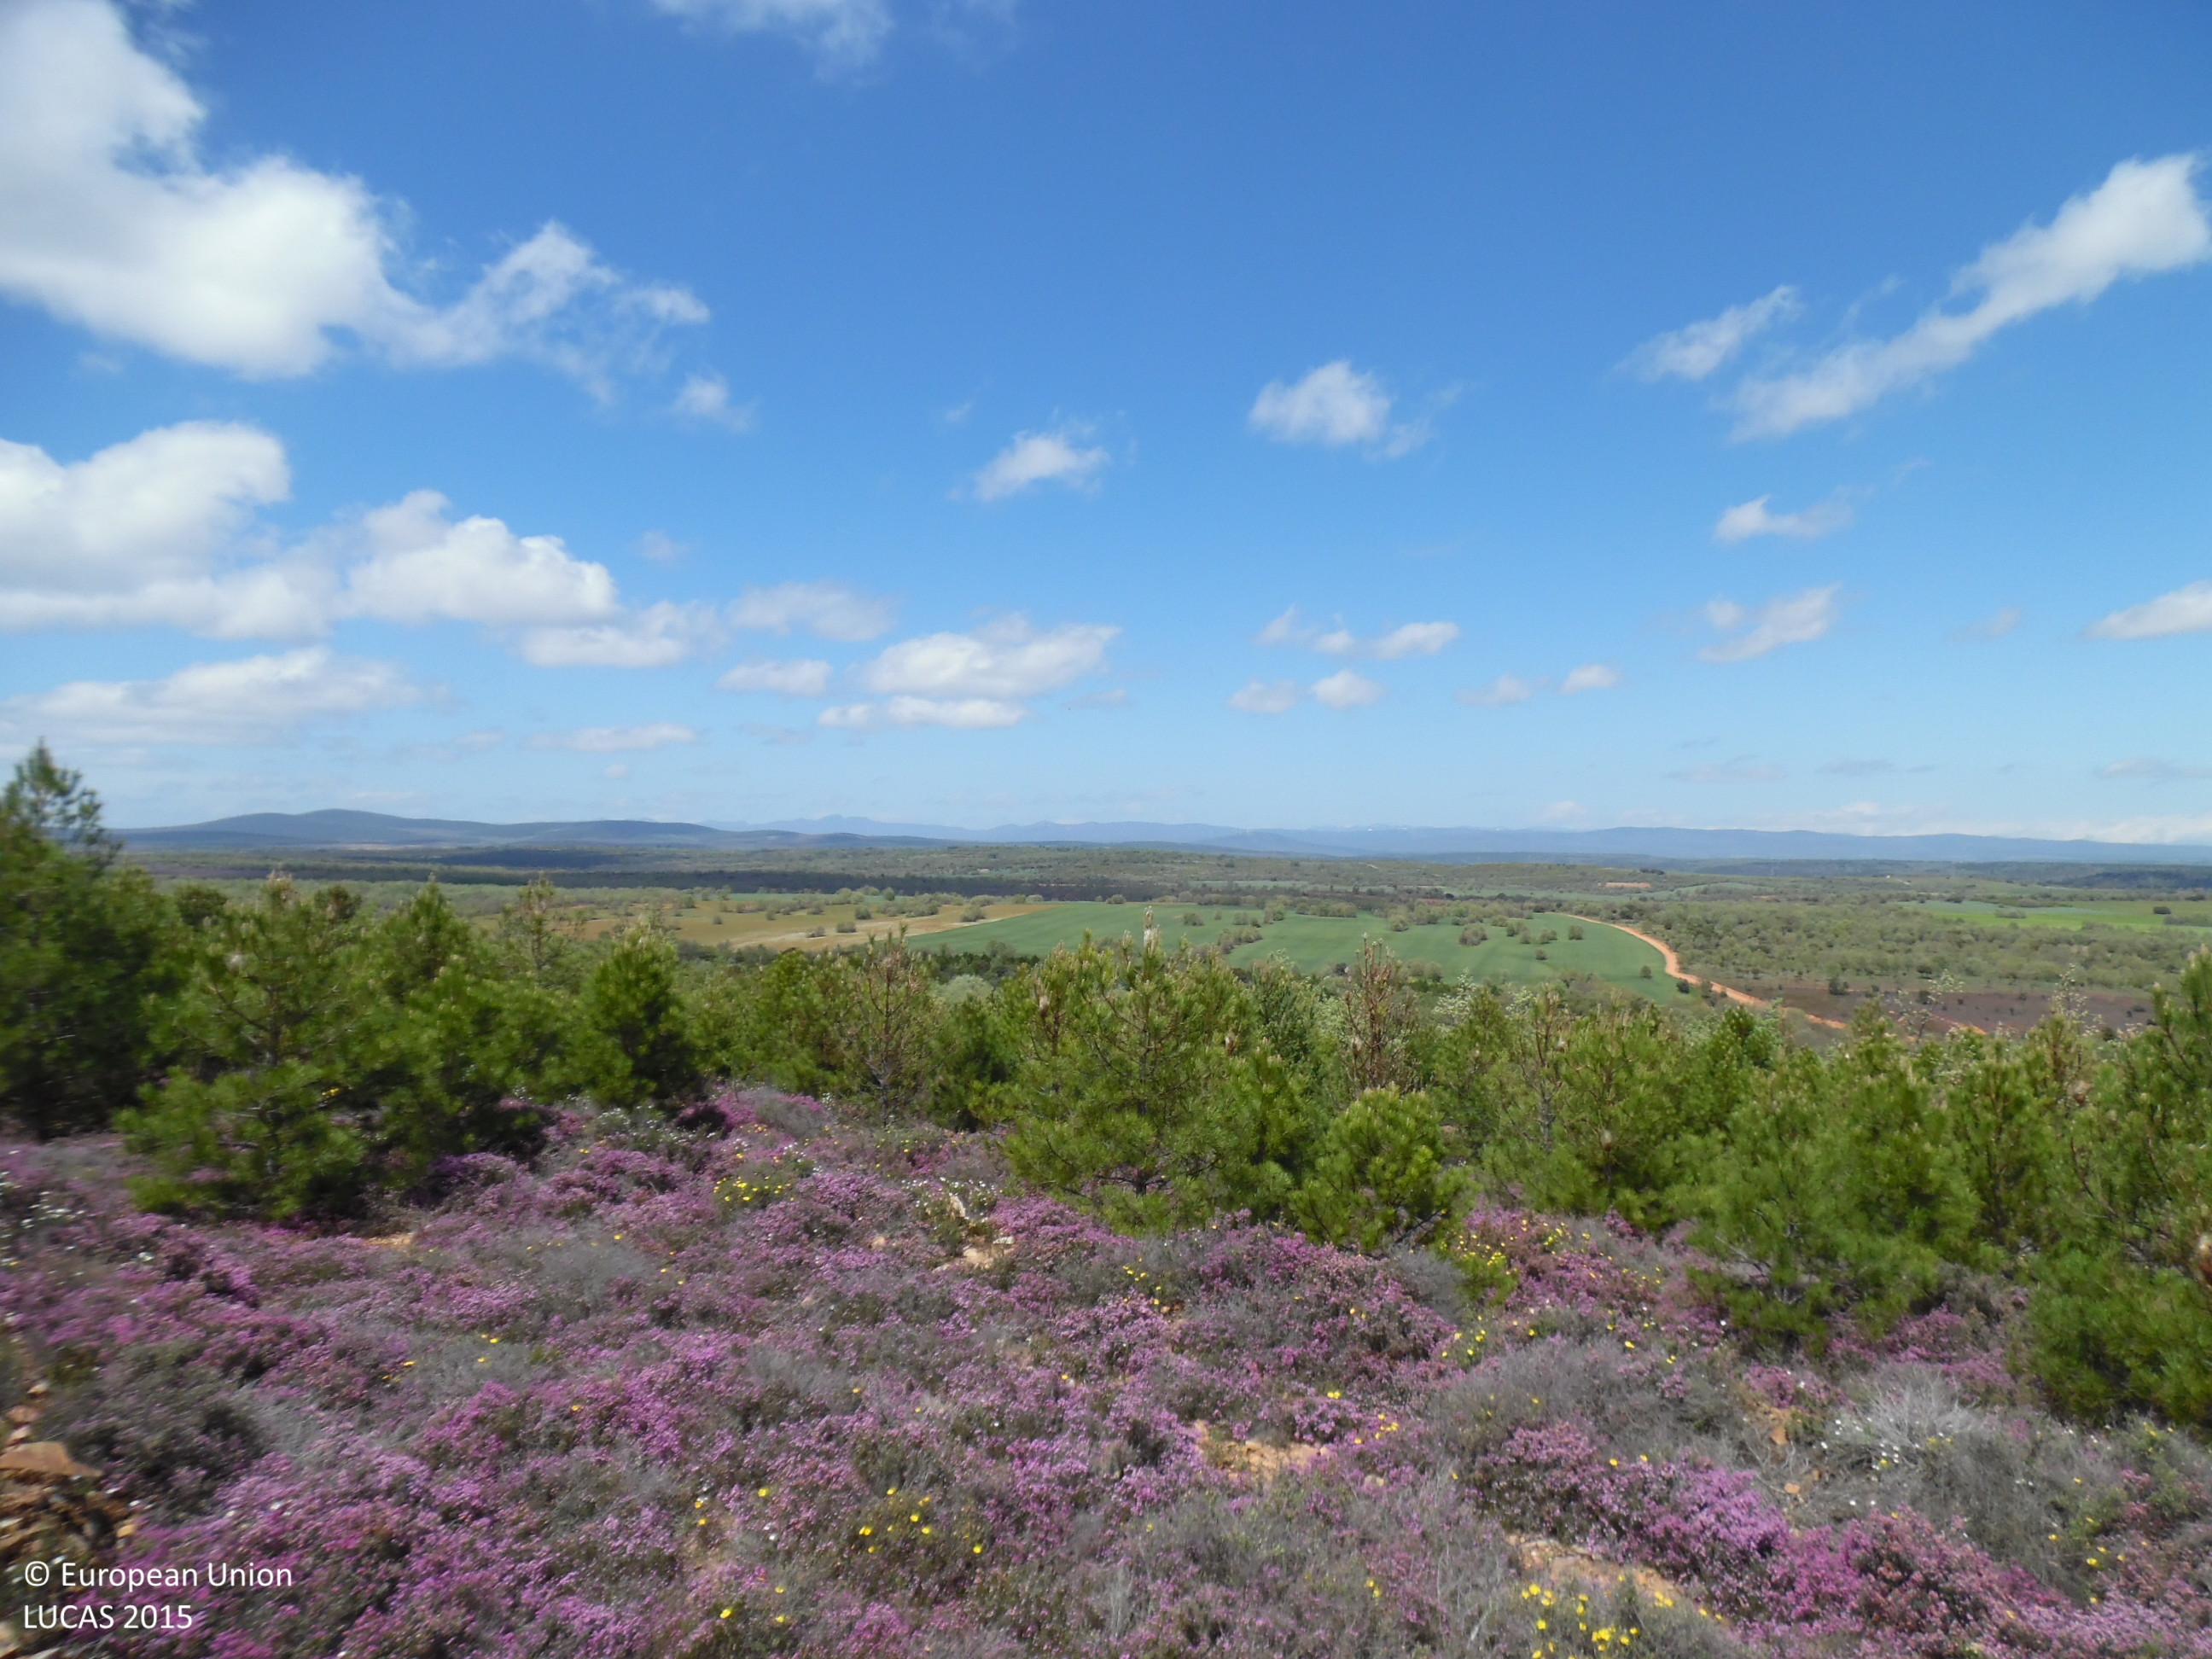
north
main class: Woodland
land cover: Pine dominated coniferous woodland
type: coniferous forest of the mediterranean region
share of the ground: > 75 %
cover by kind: coniferous forest trees 90 %, shrubs 10 %
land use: Forestry
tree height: > 5 m
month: May
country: ES
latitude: 42.4982
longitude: -6.0838
